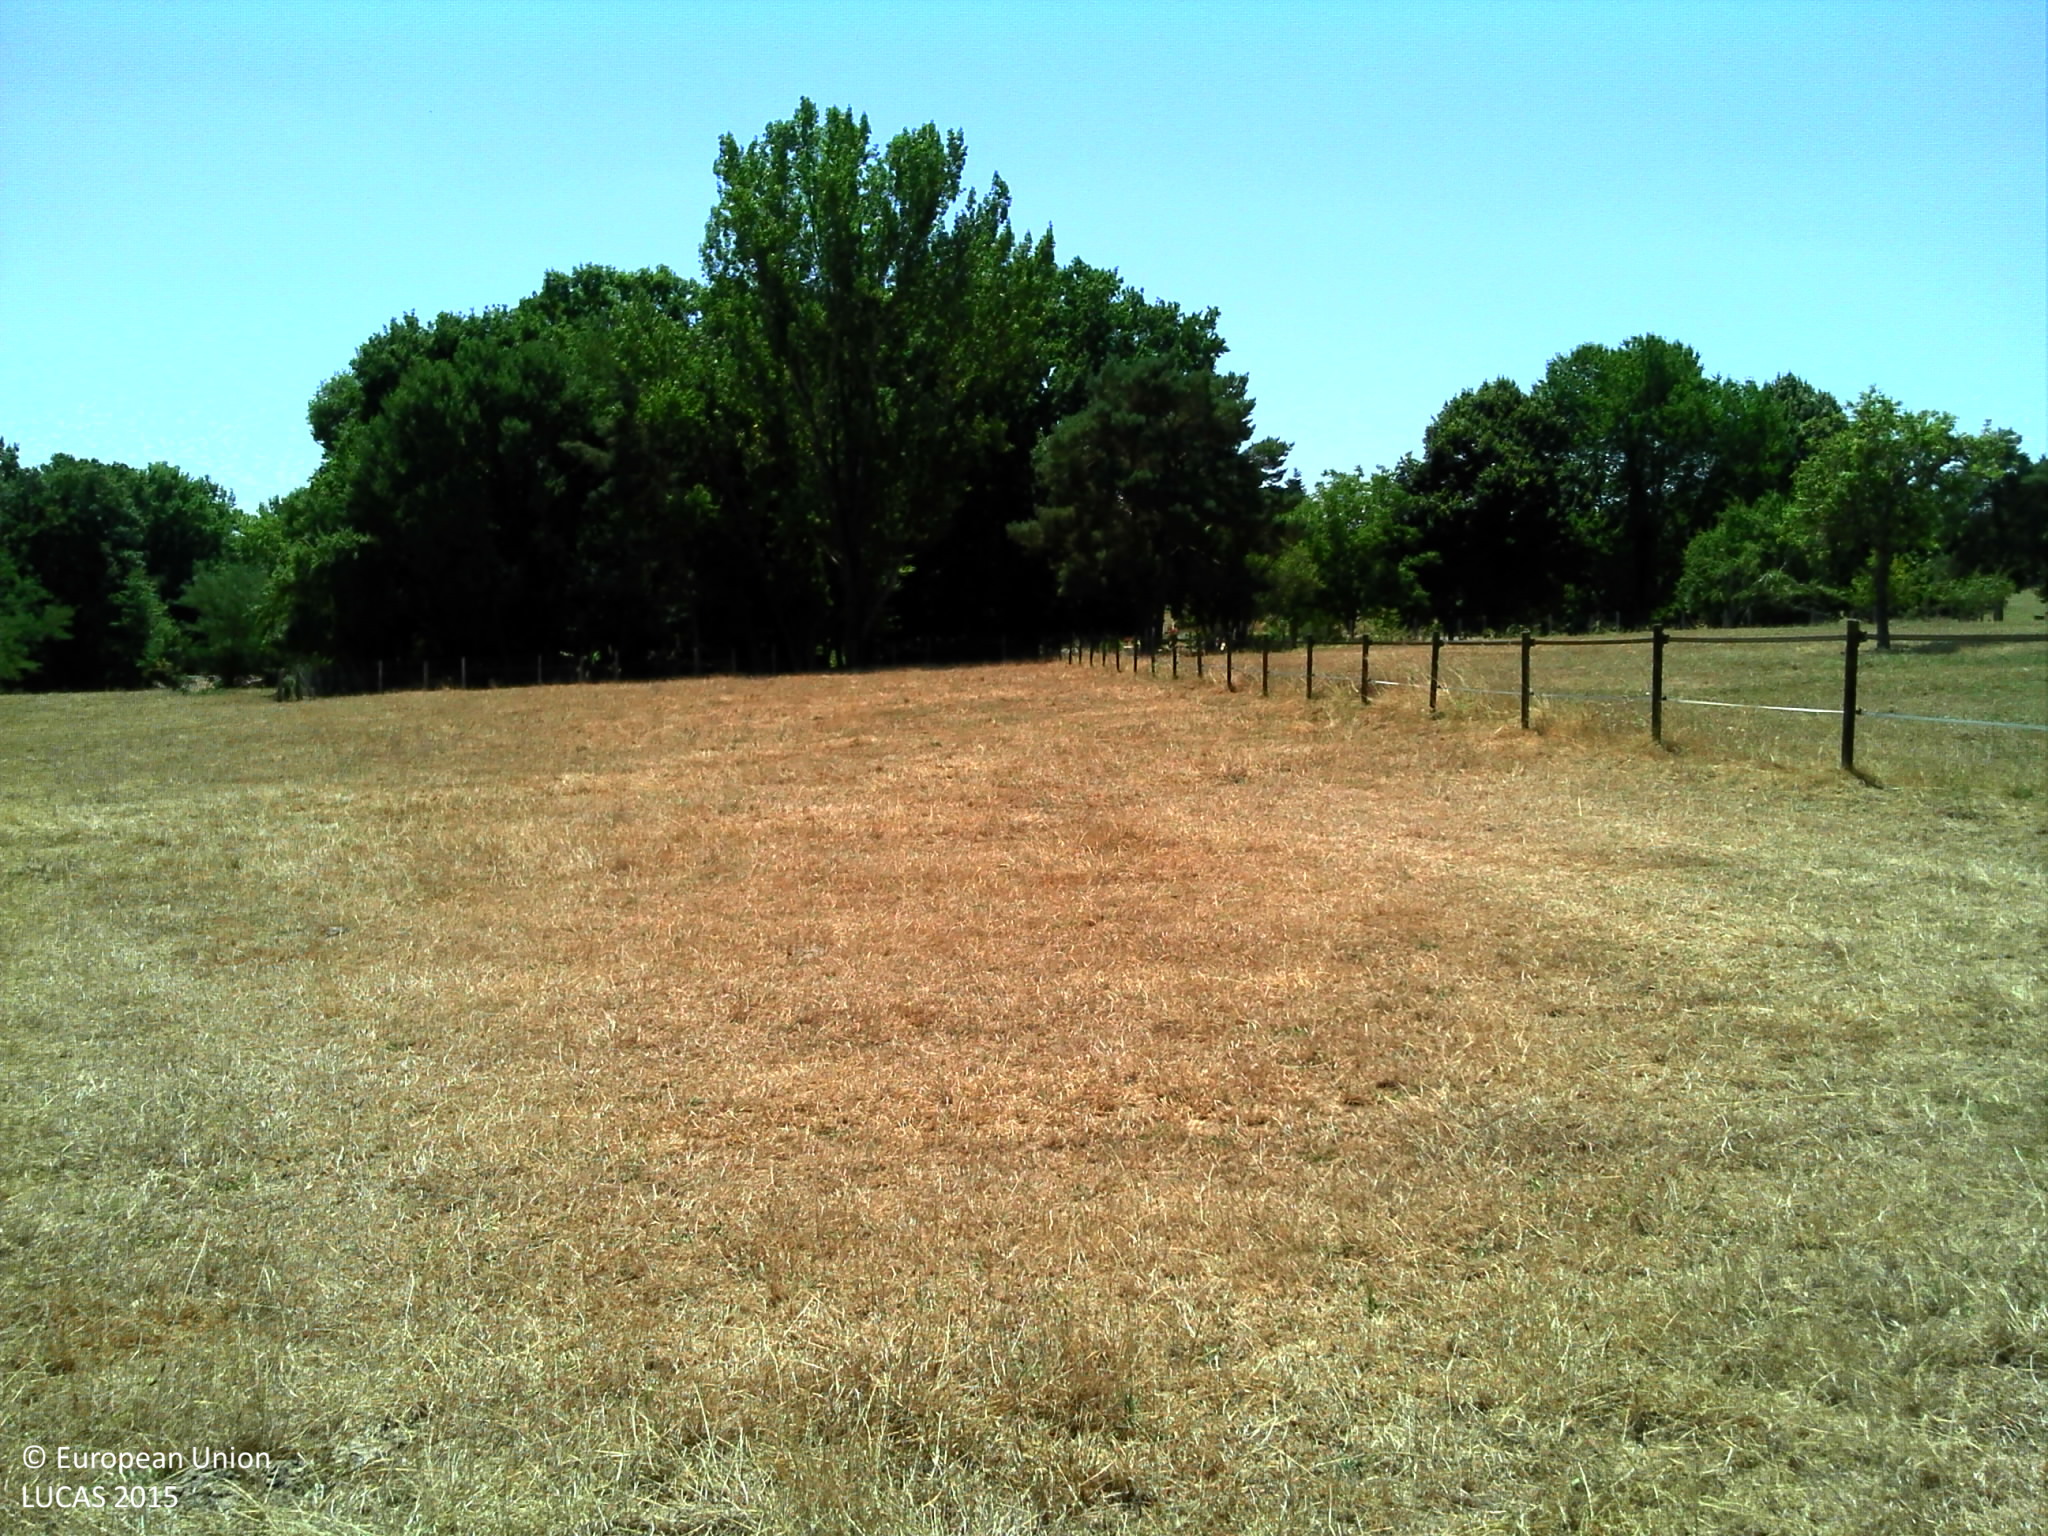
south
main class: Grassland
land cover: Grassland without tree/shrub cover
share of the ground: > 75 %
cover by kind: herbaceous plants 100 %
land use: Agriculture (excluding fallow land and kitchen gardens)
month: July
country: FR
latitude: 44.8654
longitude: 0.5872
